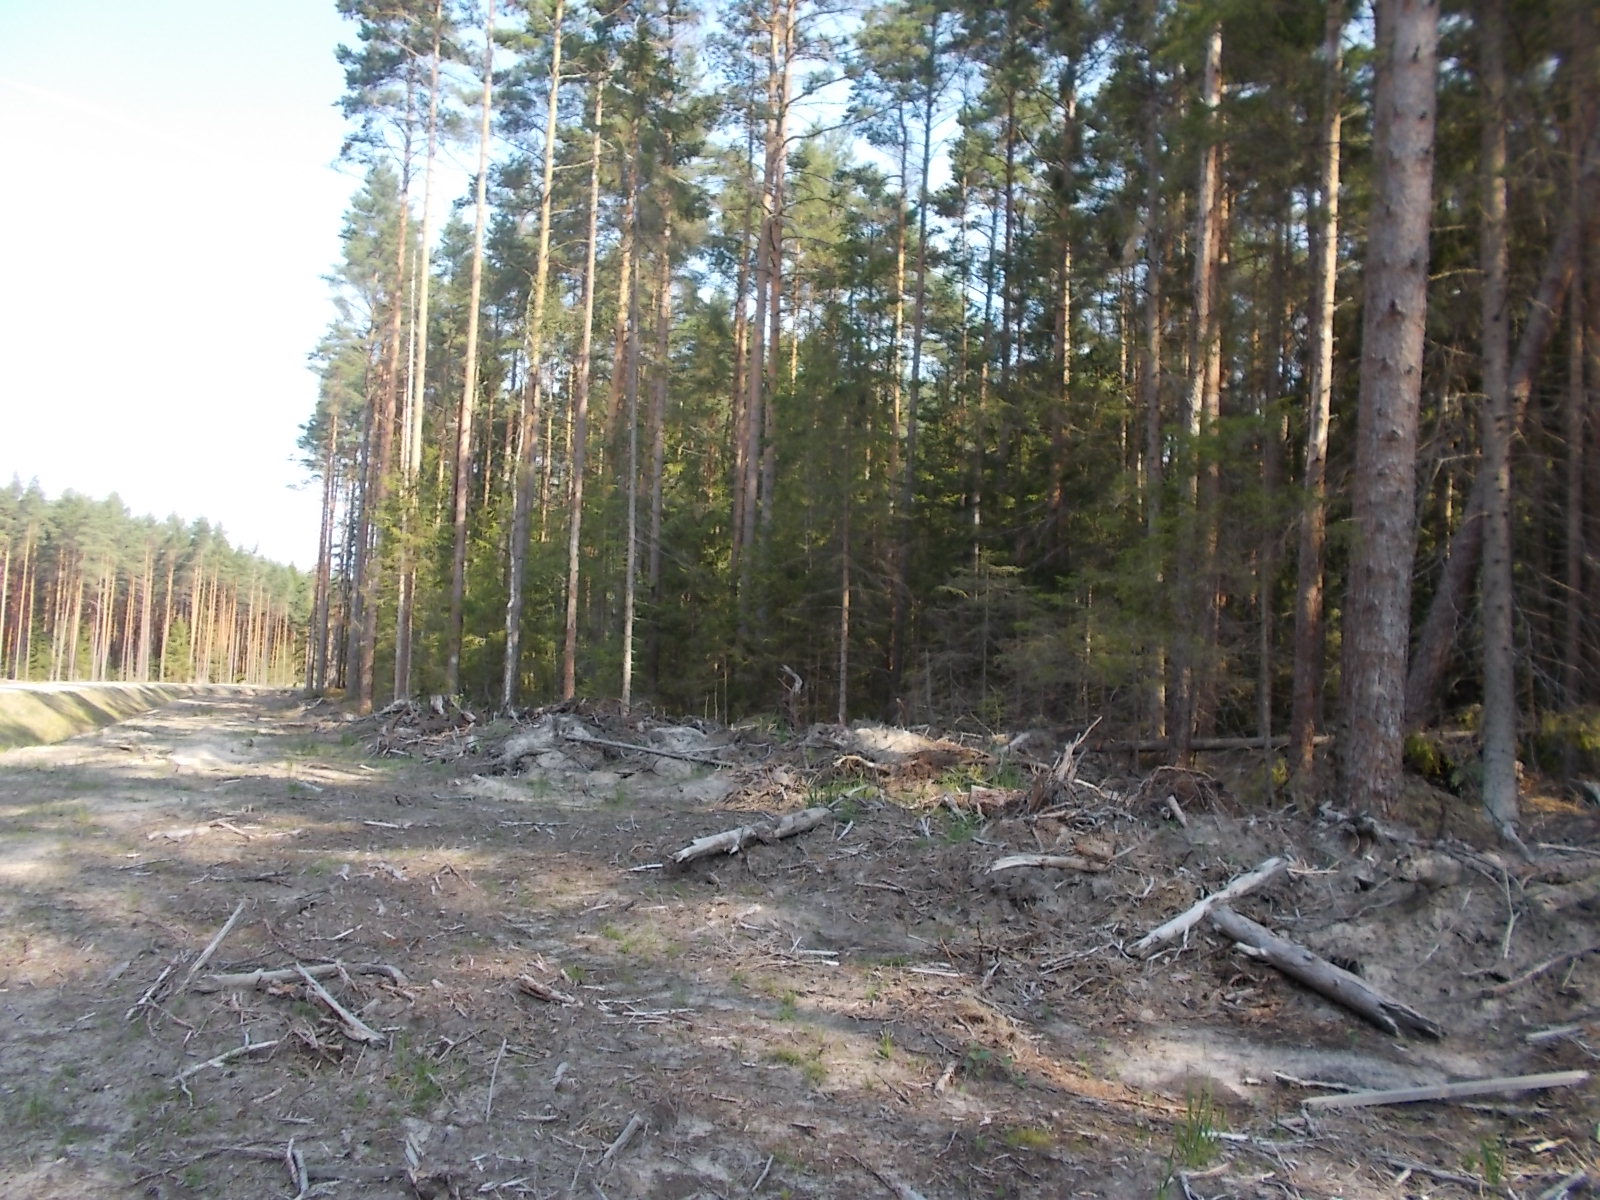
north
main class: Grassland
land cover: Spontaneously vegetated surfaces
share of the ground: 25 - 50 %
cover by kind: herbaceous plants 35 %, unconsolidated bare surface 30 %, lichens and mosses 5 %
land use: Forestry
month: August
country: LV
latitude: 57.1013
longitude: 21.5462
